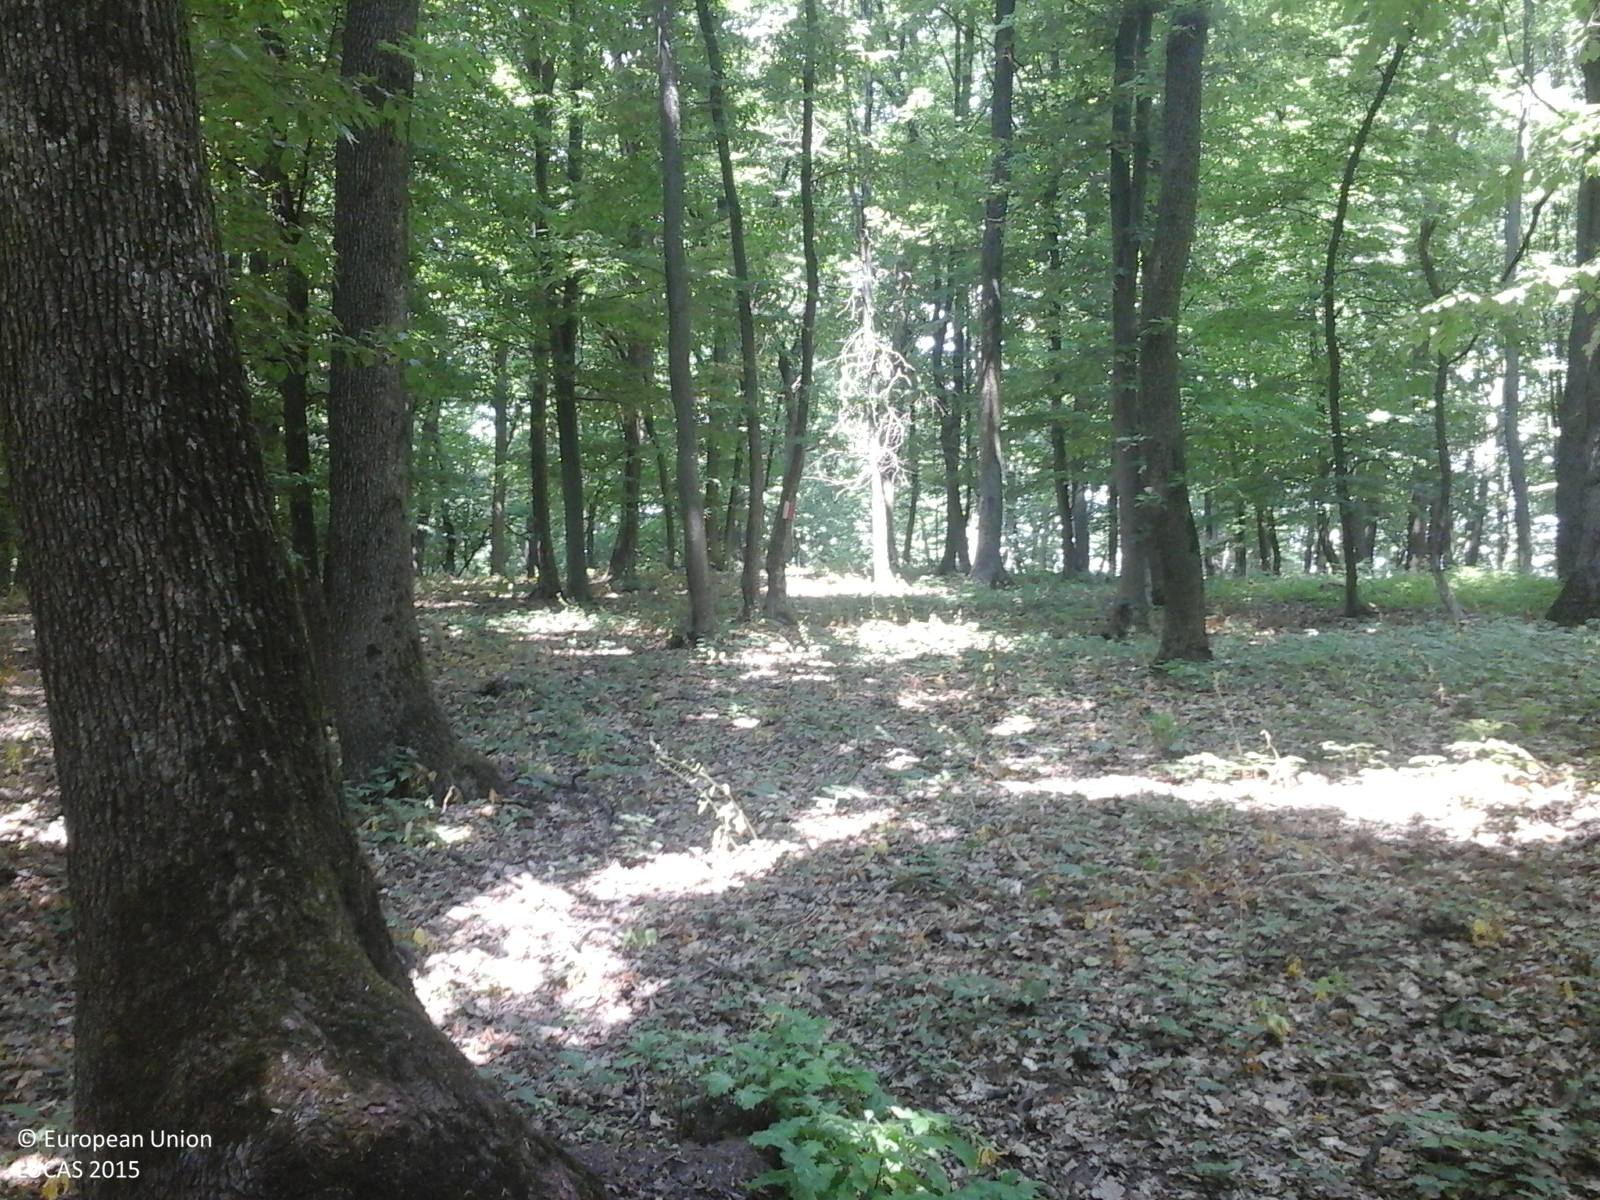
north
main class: Woodland
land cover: Broadleaved woodland
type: mesophytic deciduous forest
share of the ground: > 75 %
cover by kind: broadleaved forest trees 100 %
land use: Forestry
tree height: > 5 m
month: June
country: RO
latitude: 46.3707
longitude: 27.1413
